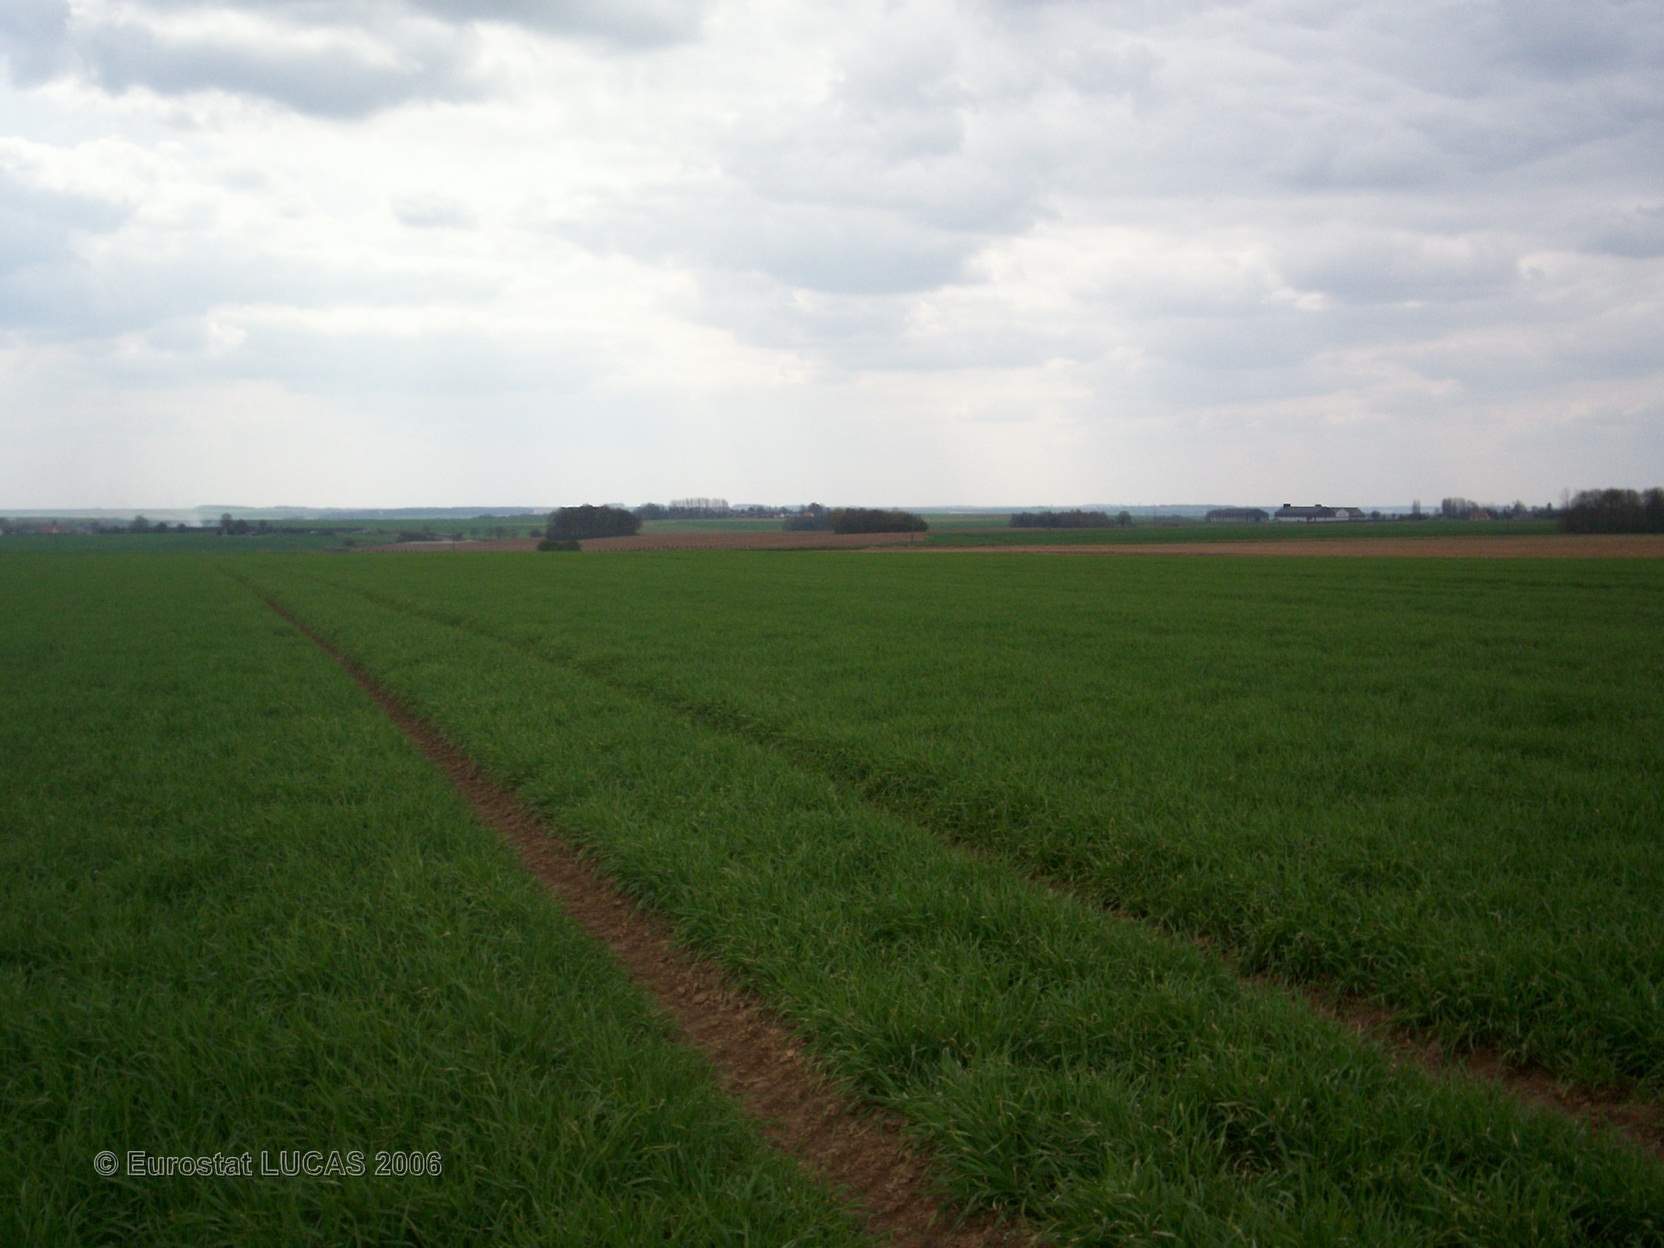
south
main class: Cropland
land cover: Common wheat
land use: Agriculture (excluding fallow land and kitchen gardens)
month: April
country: FR
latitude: 50.0144
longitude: 2.5778
